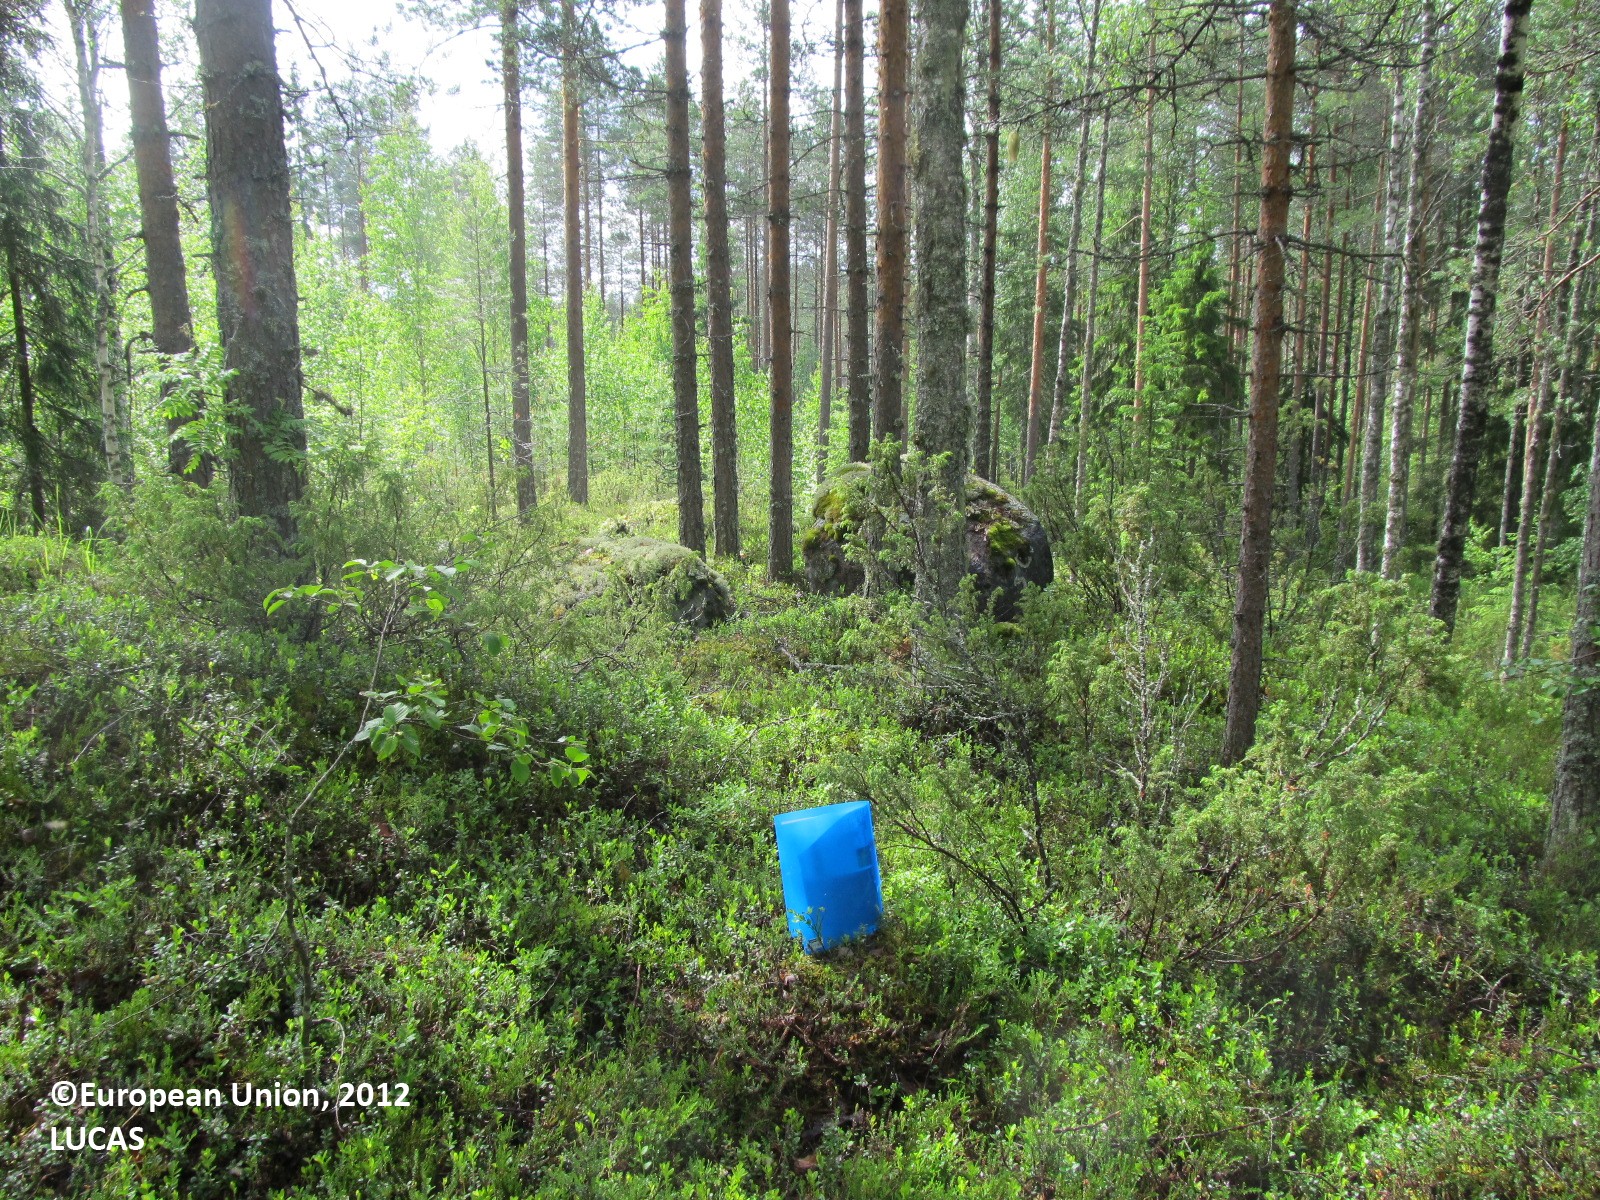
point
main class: Woodland
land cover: Pine dominated coniferous woodland
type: boreal forest
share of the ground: 25 - 50 %
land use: Forestry
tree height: > 5 m
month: June
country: FI
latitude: 63.0321
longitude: 28.8054
